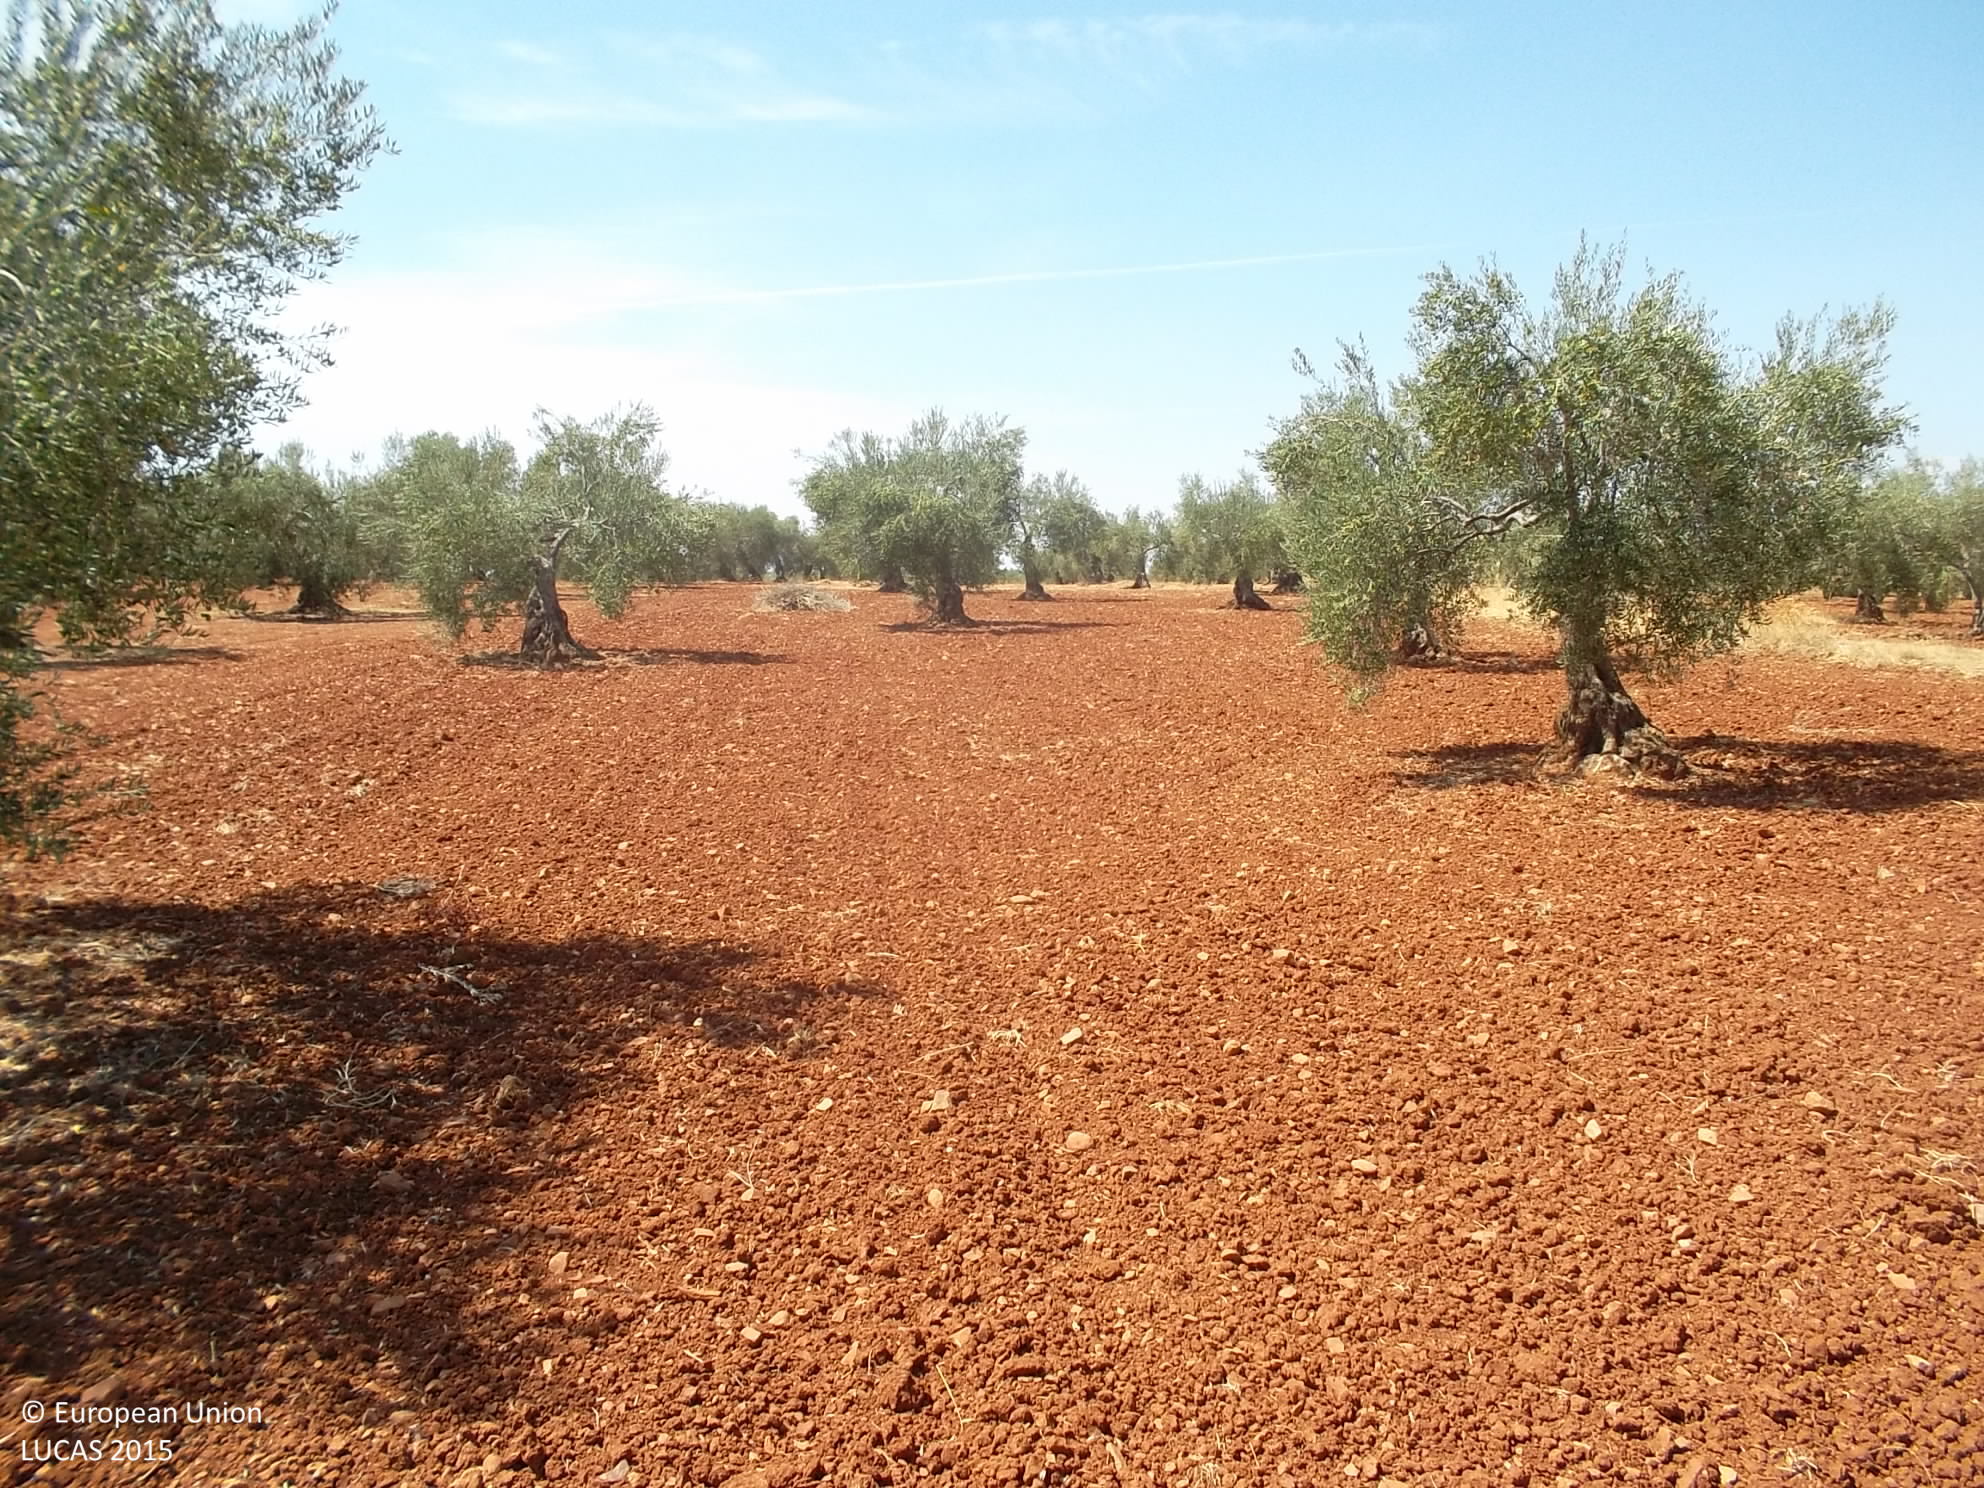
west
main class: Cropland
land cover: Olive groves
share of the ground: 10 - 25 %
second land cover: Other bare soil
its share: > 75 %
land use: Agriculture (excluding fallow land and kitchen gardens)
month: September
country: ES
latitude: 38.3680
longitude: -6.3580
